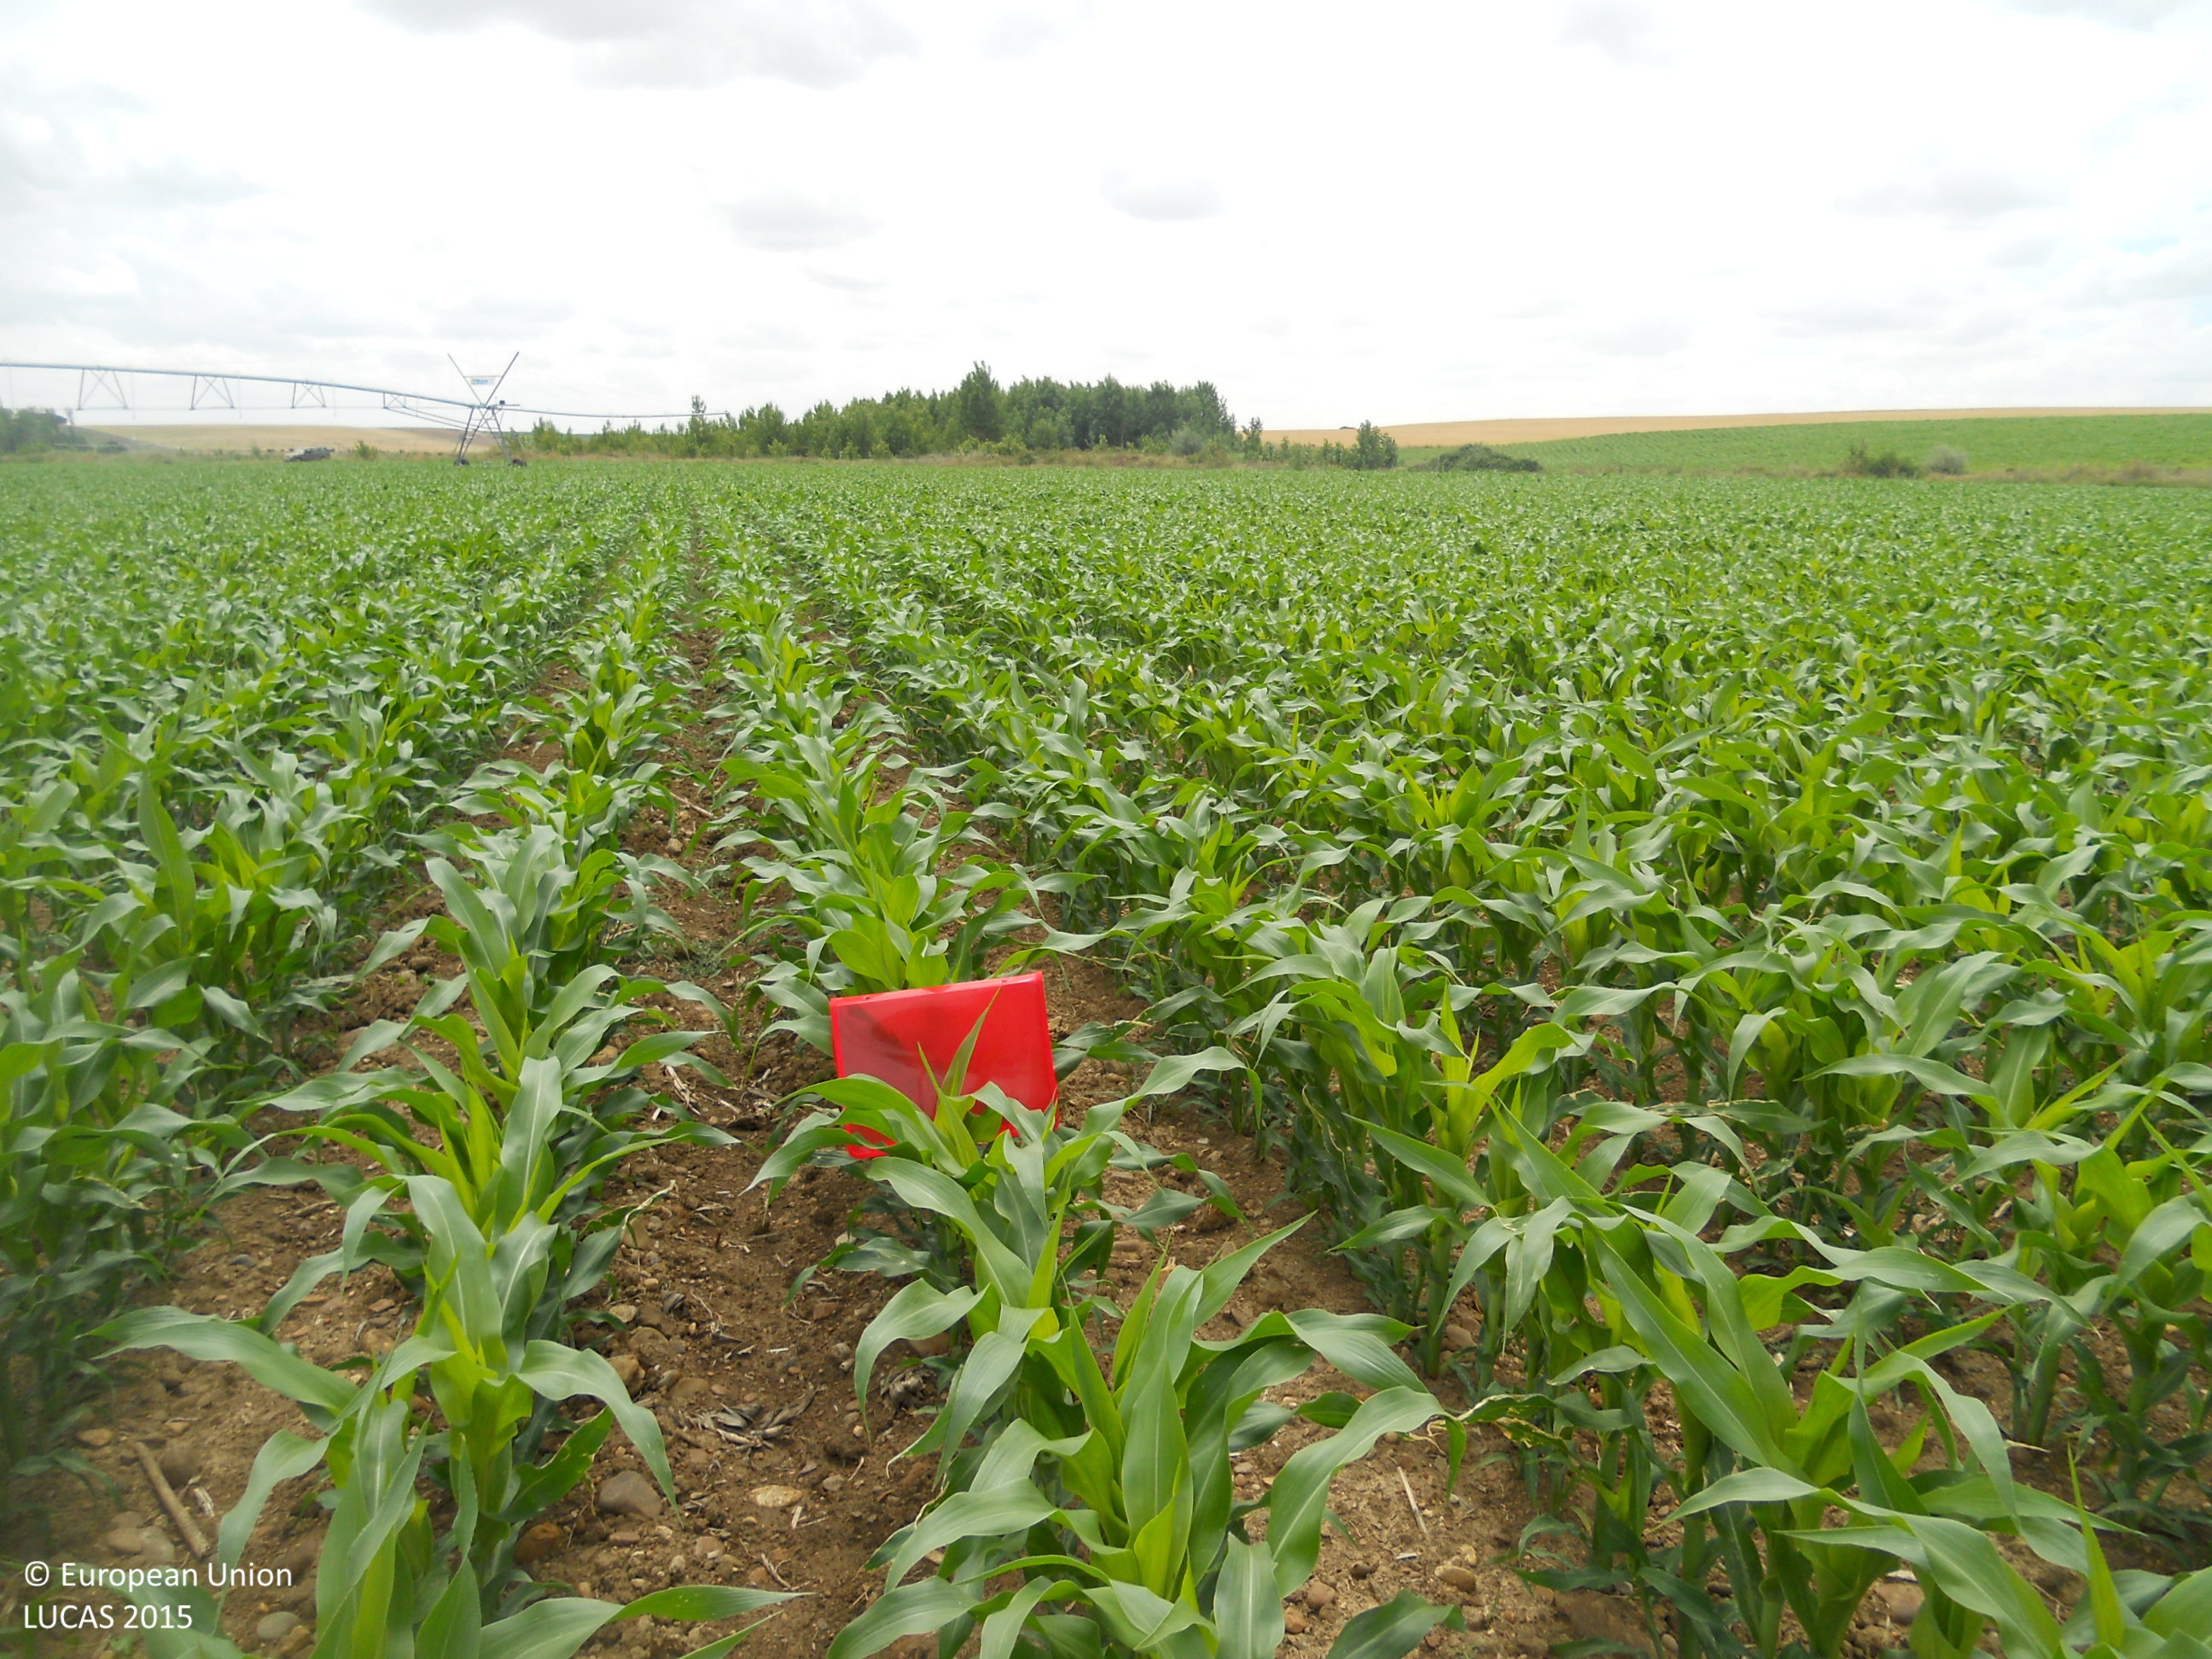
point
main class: Cropland
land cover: Maize
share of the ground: > 75 %
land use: Agriculture (excluding fallow land and kitchen gardens)
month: June
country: ES
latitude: 42.2969
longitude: -5.2610
